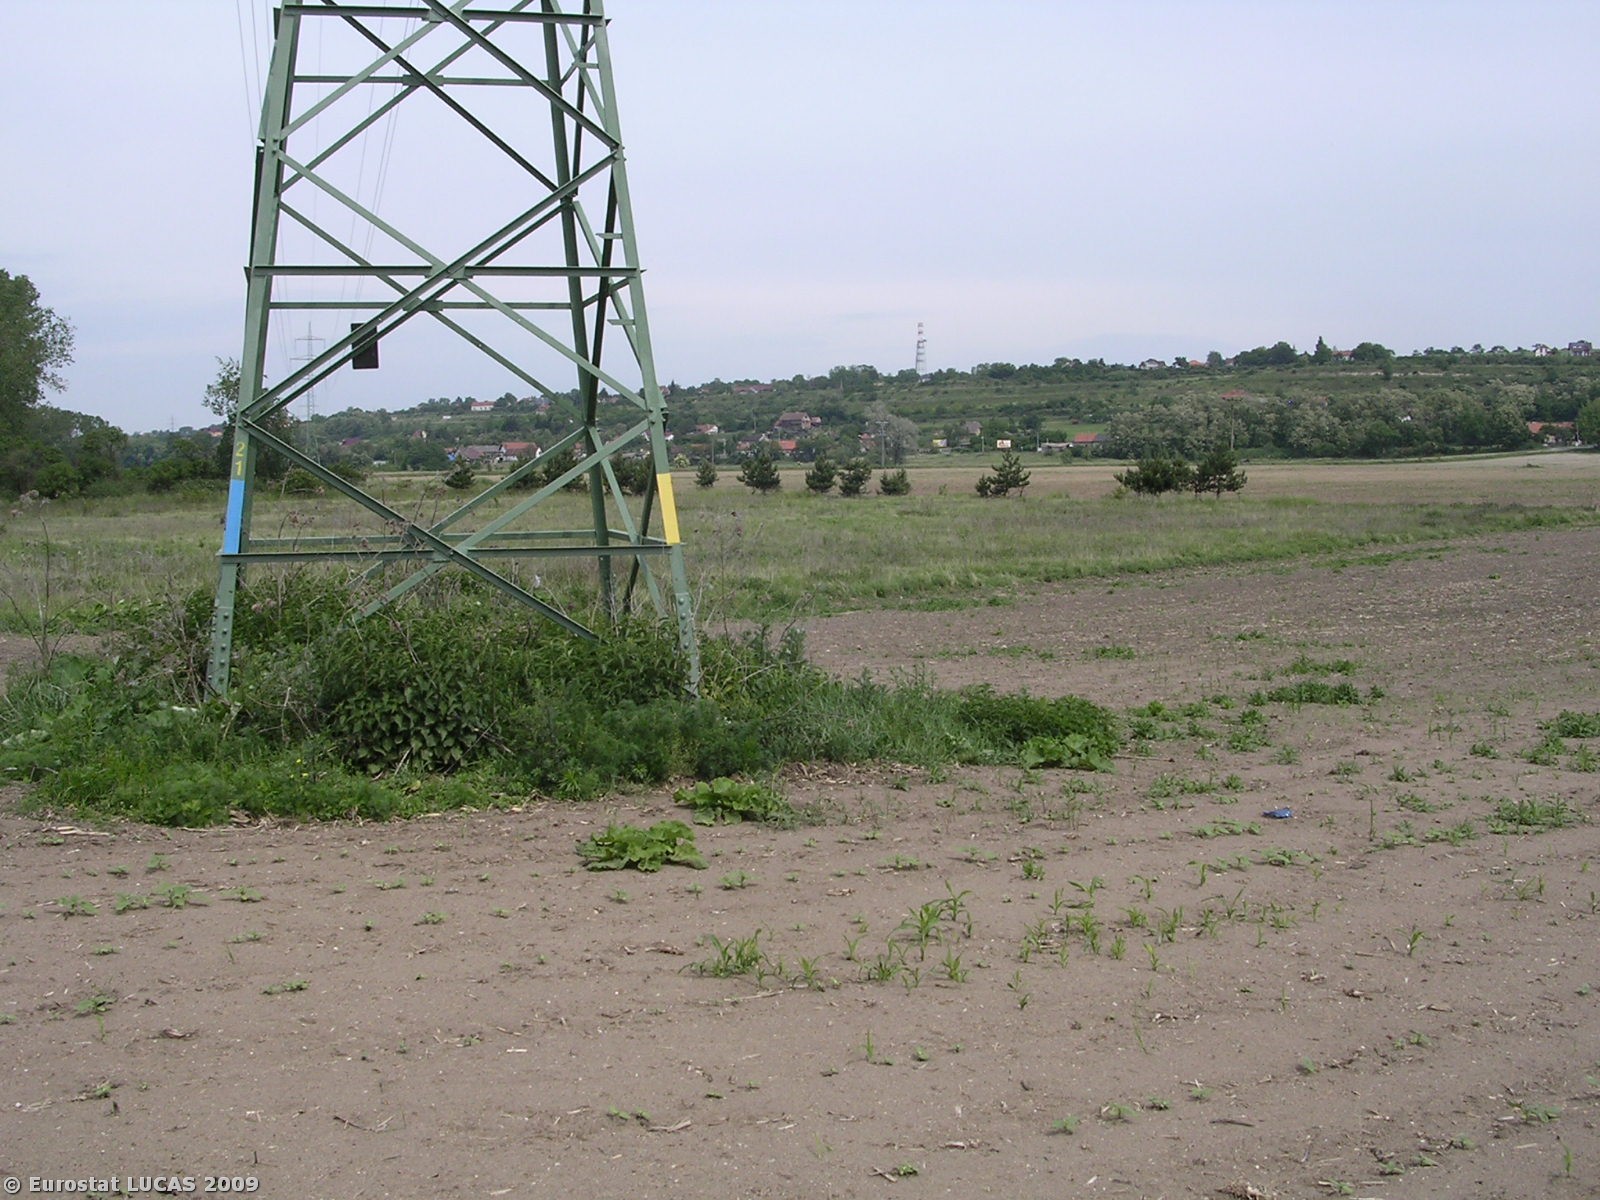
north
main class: Cropland
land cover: Sunflower
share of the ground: < 10 %
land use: Agriculture (excluding fallow land and kitchen gardens)
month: May
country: CZ
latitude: 50.3112
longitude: 14.5093
